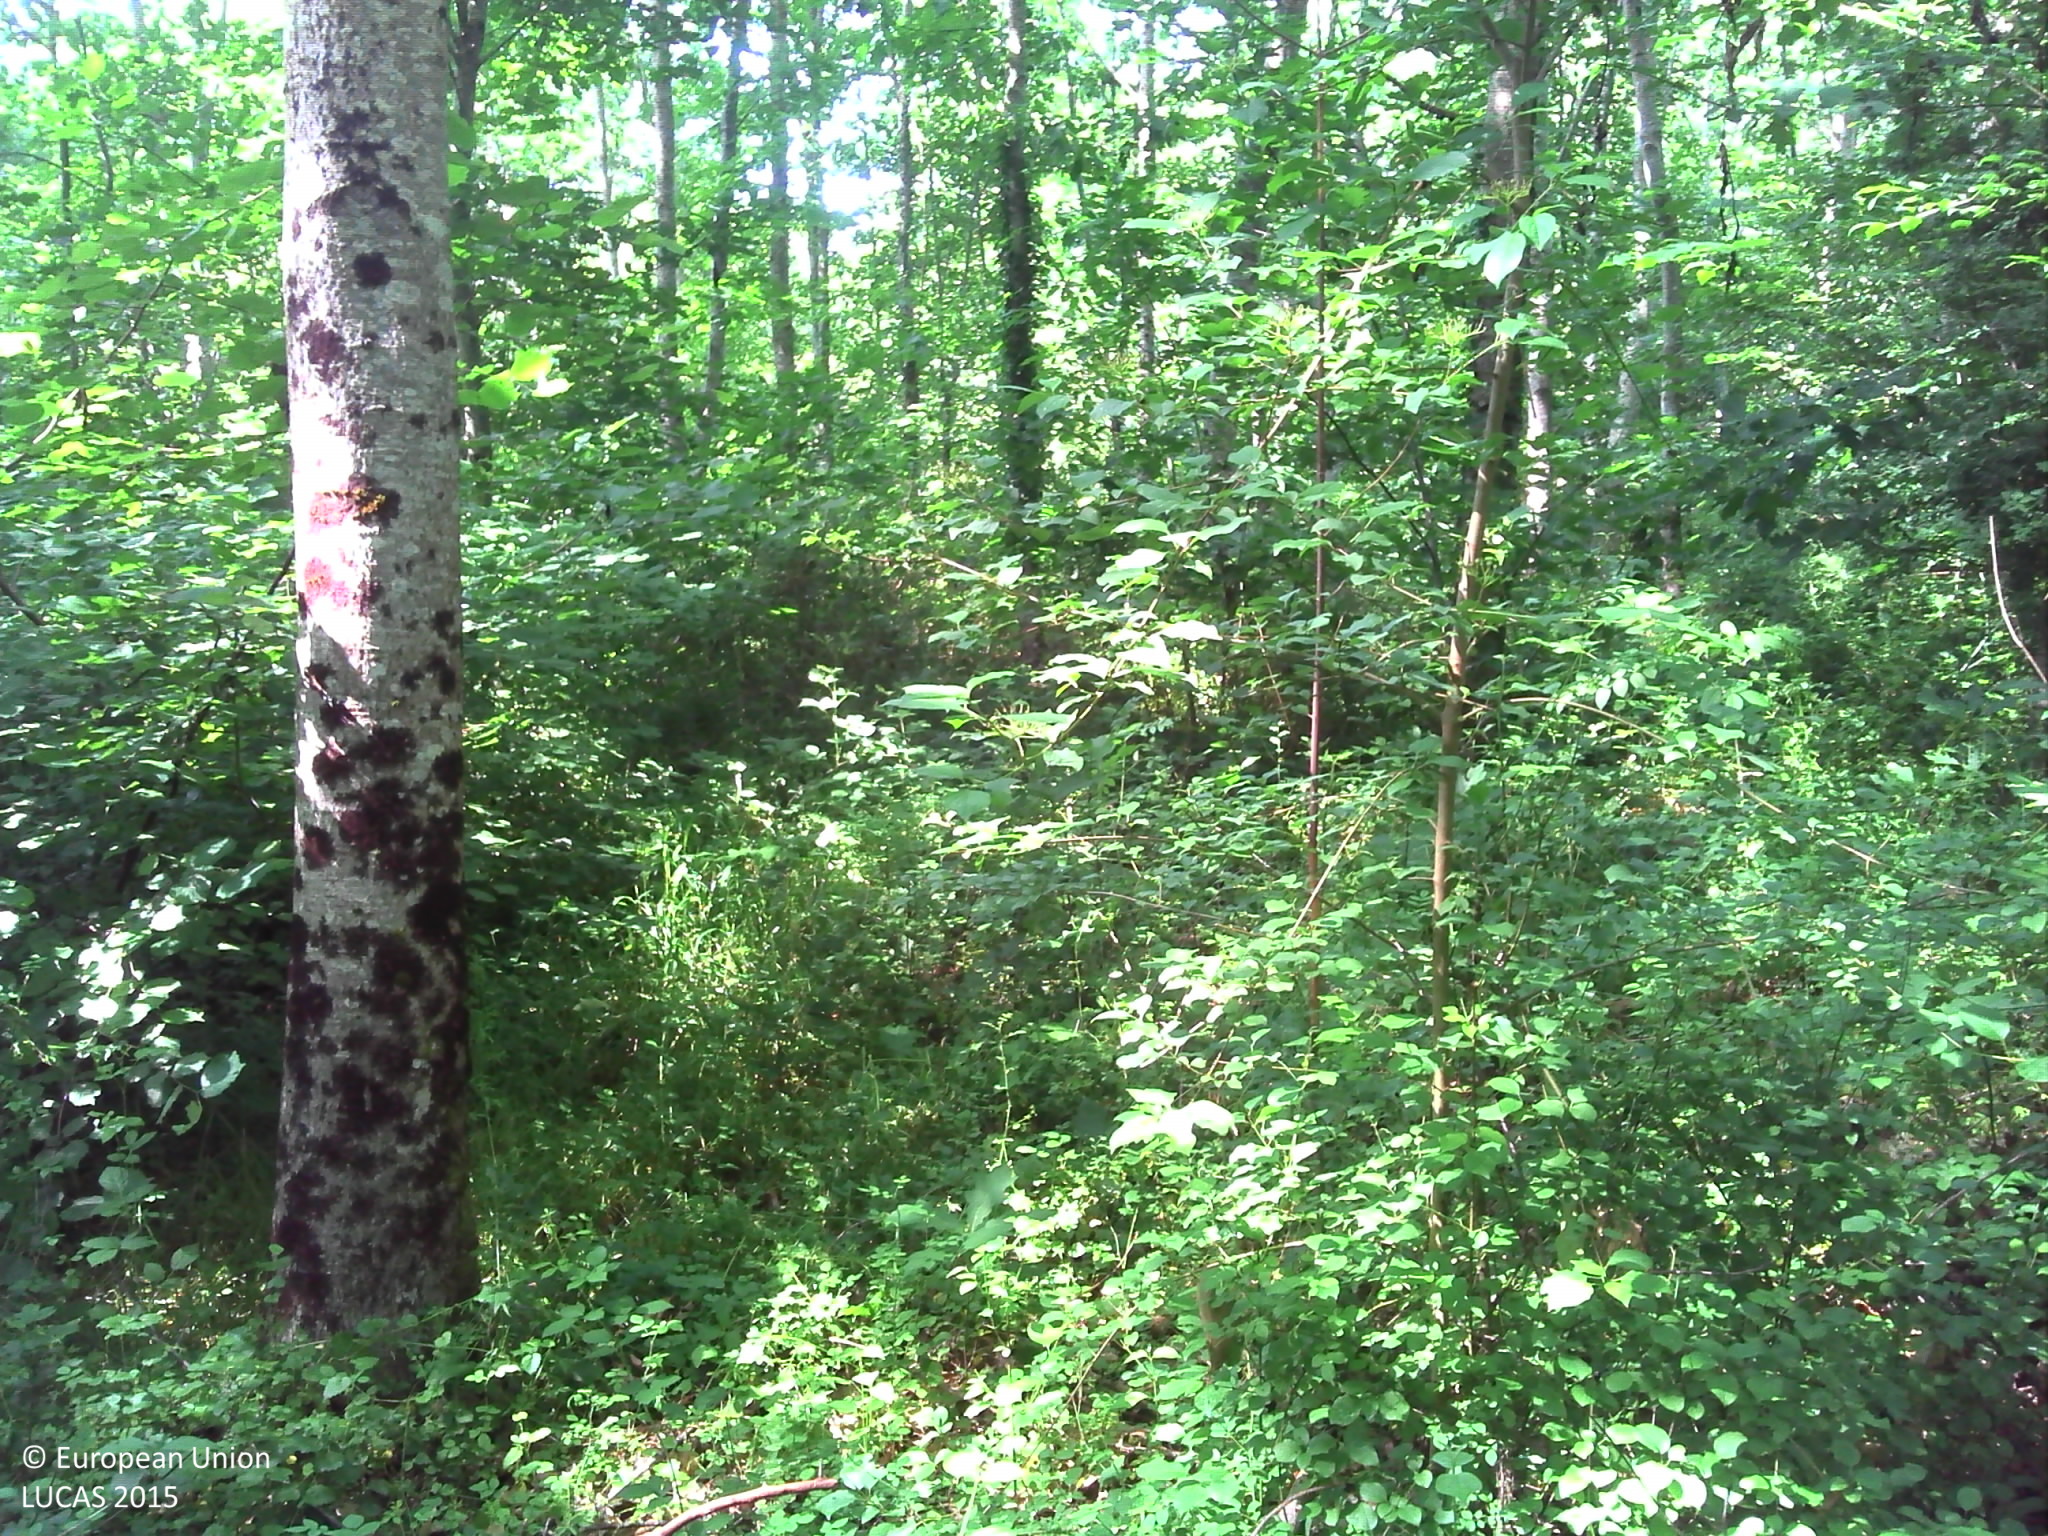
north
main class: Woodland
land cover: Broadleaved woodland
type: acidophilous oak and oak-birch forest
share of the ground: > 75 %
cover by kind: broadleaved forest trees 100 %
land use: Forestry
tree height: > 5 m
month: June
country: FR
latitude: 45.8704
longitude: 0.6727
